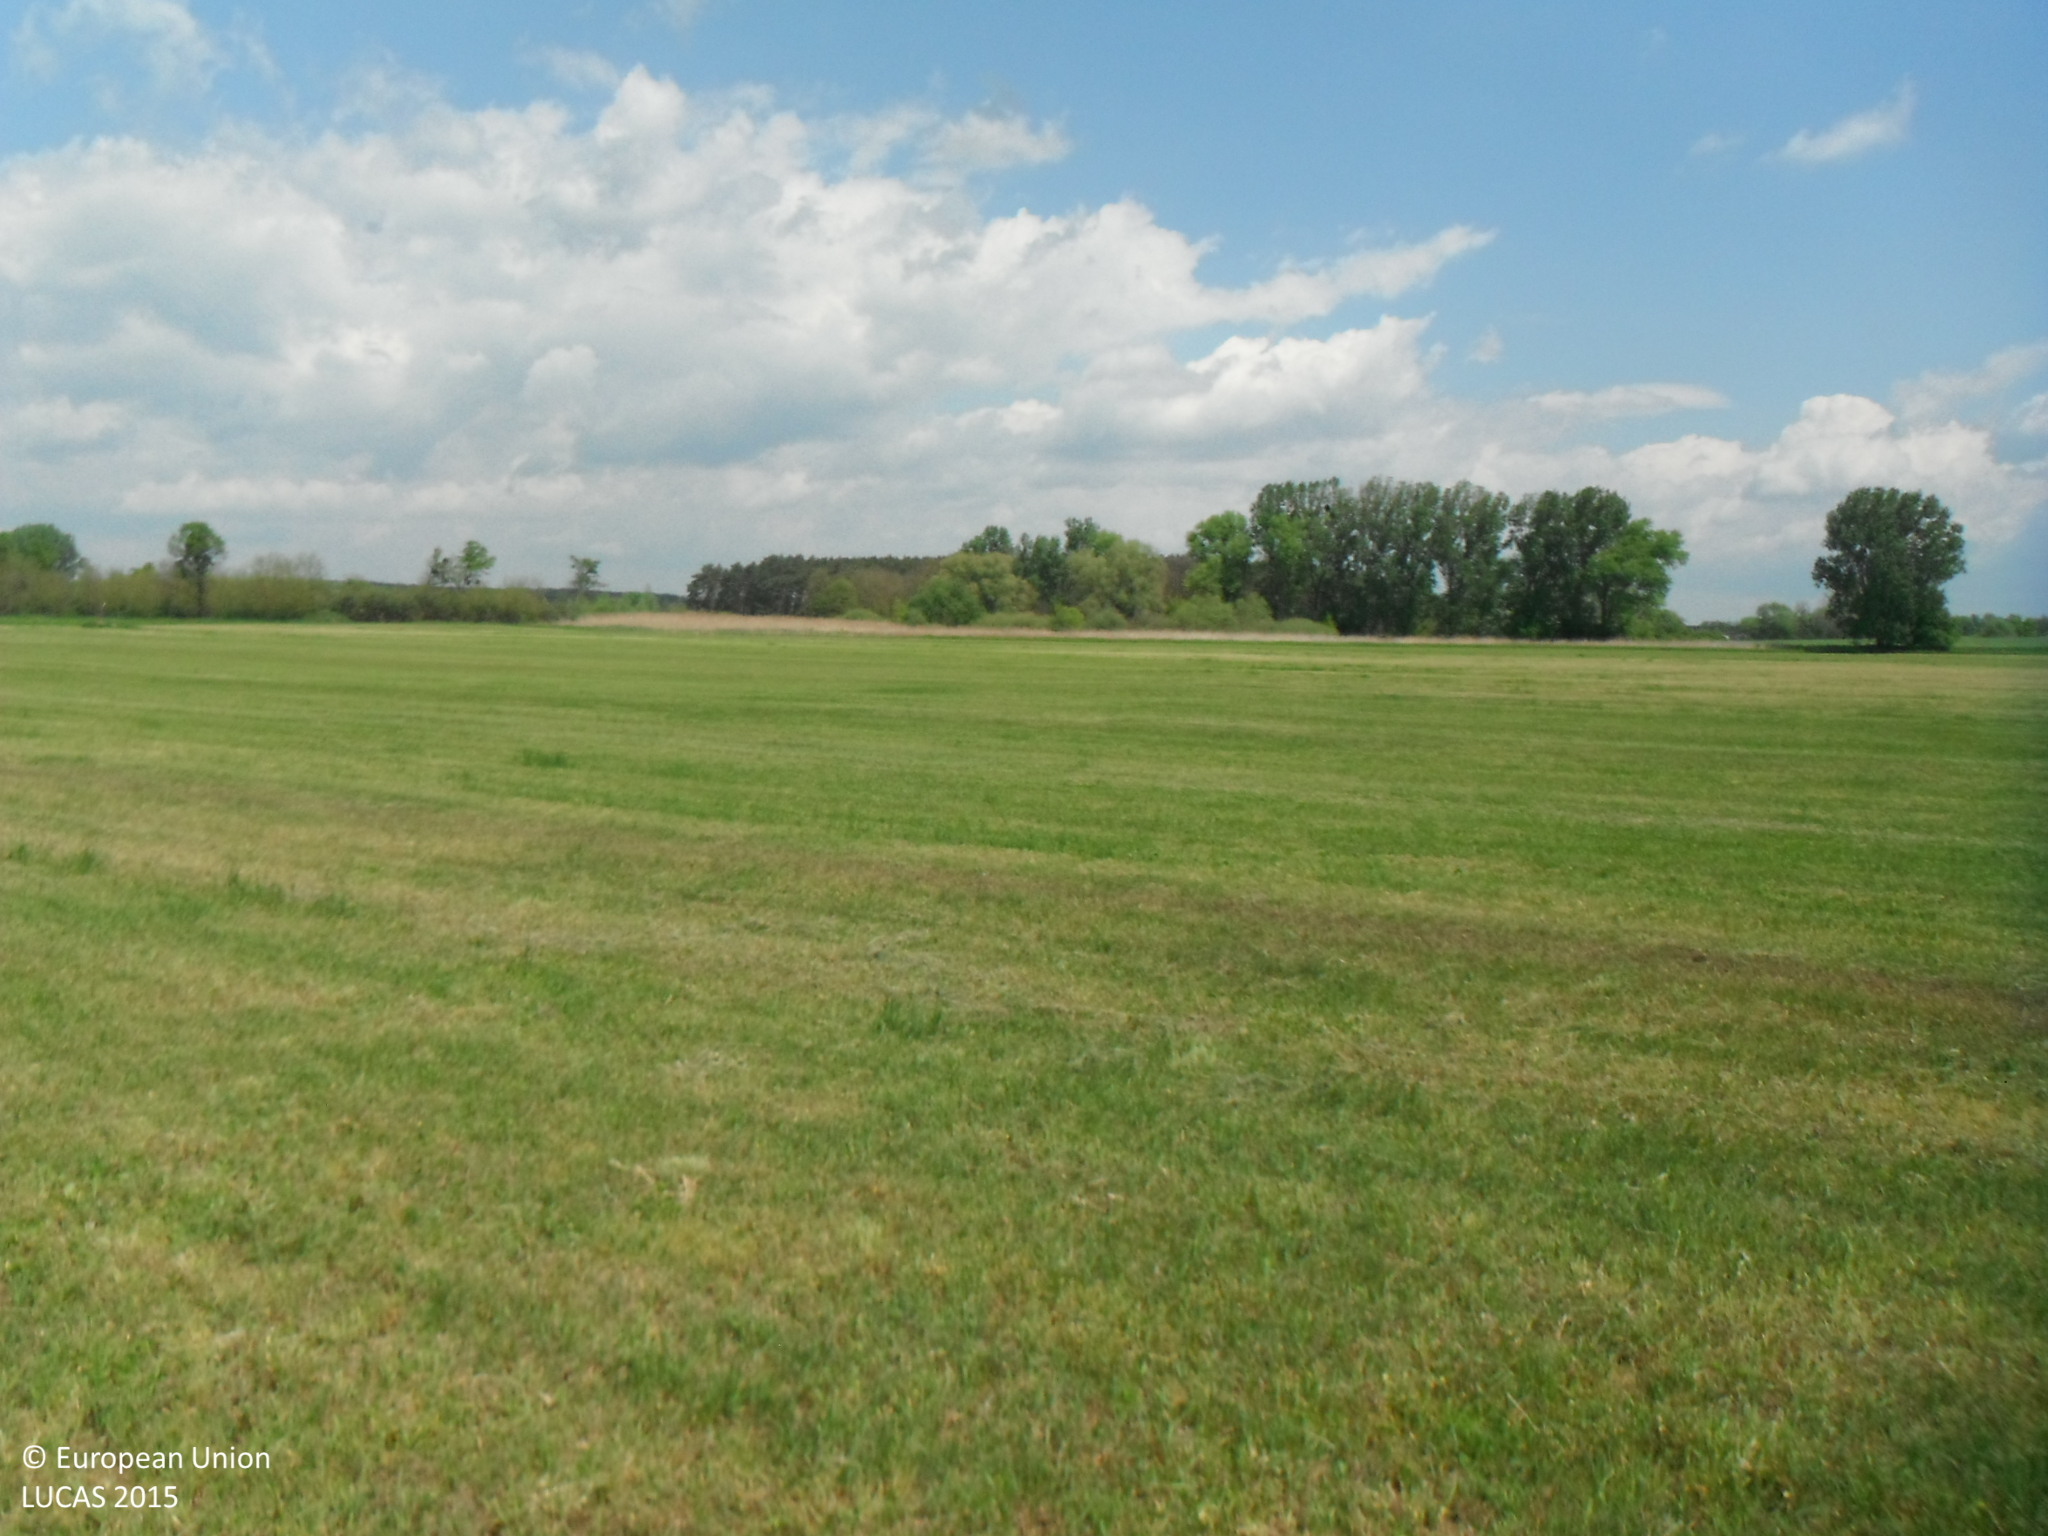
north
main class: Grassland
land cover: Grassland without tree/shrub cover
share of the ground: > 75 %
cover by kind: herbaceous plants 100 %
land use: Agriculture (excluding fallow land and kitchen gardens)
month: May
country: SK
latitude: 48.5582
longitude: 17.0405
